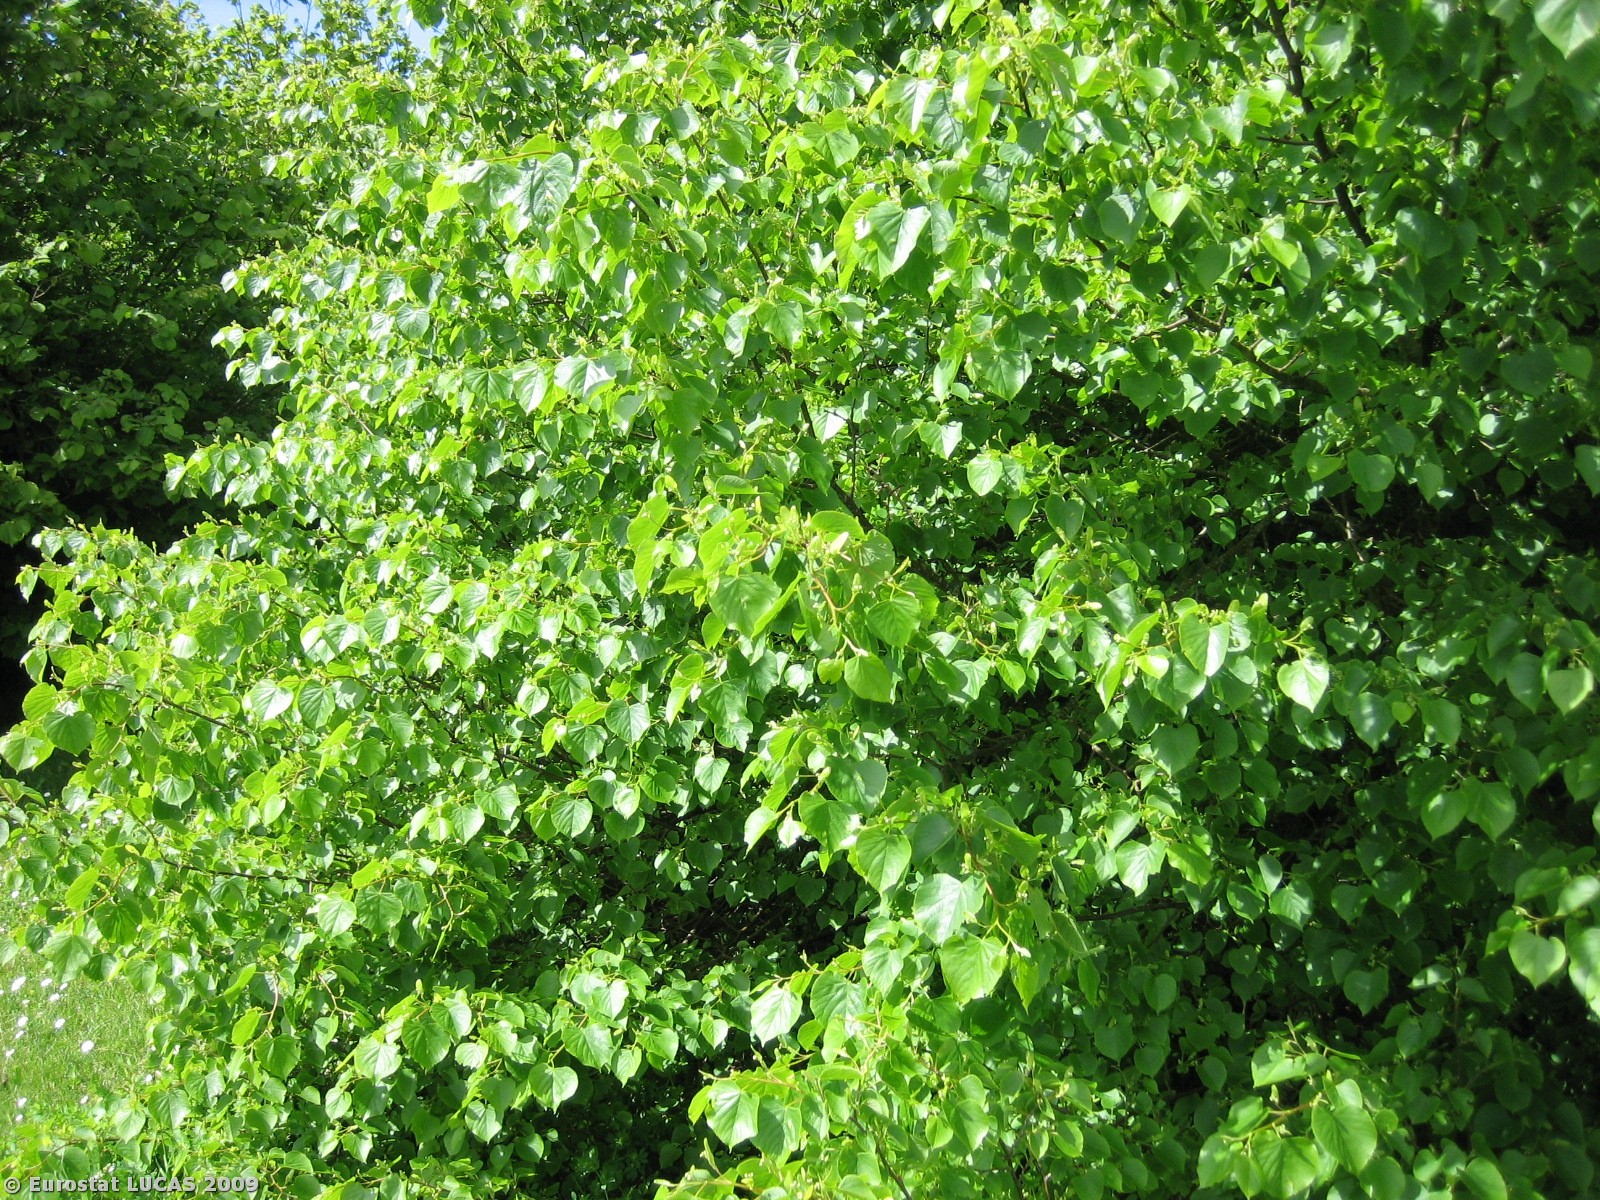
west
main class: Shrubland
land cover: Shrubland with sparse tree cover
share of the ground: > 75 %
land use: Amenities, museums, leisure
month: May
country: DK
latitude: 56.1118
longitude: 8.9880
